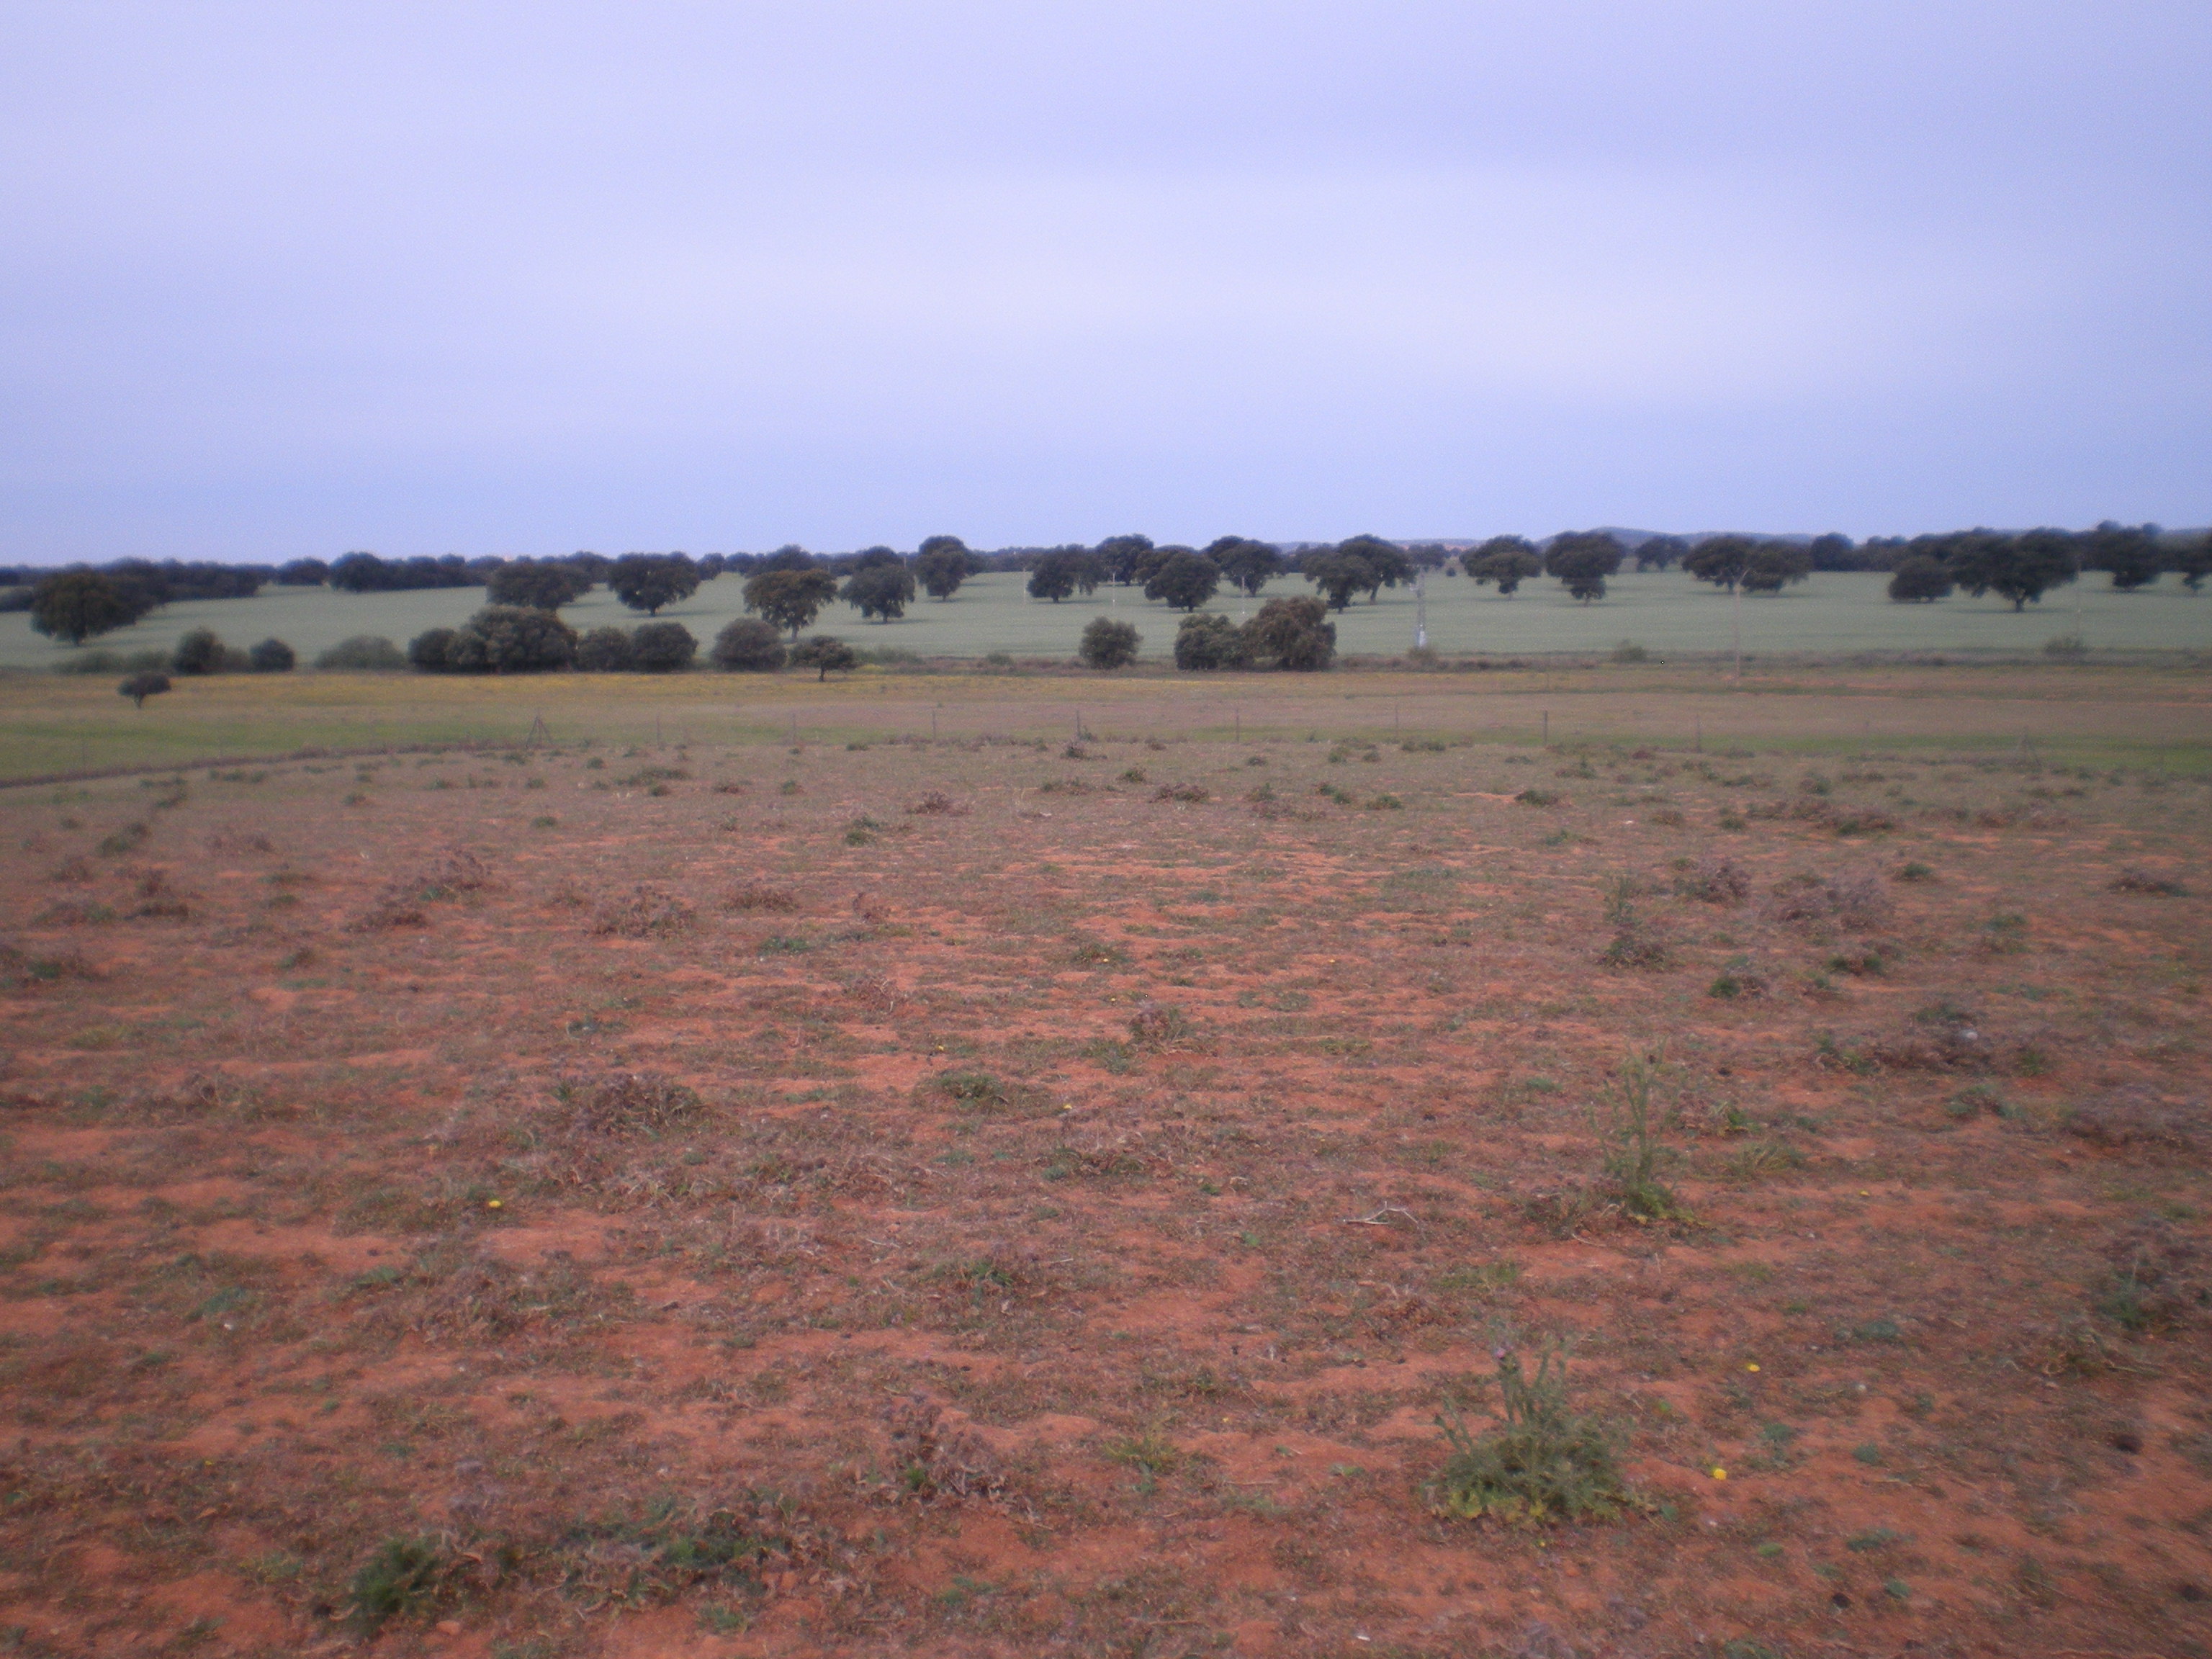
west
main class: Grassland
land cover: Spontaneously vegetated surfaces
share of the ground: 25 - 50 %
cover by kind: unconsolidated bare surface 75 %, herbaceous plants 25 %
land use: Agriculture (excluding fallow land and kitchen gardens)
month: May
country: ES
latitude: 38.6615
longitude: -3.1658
